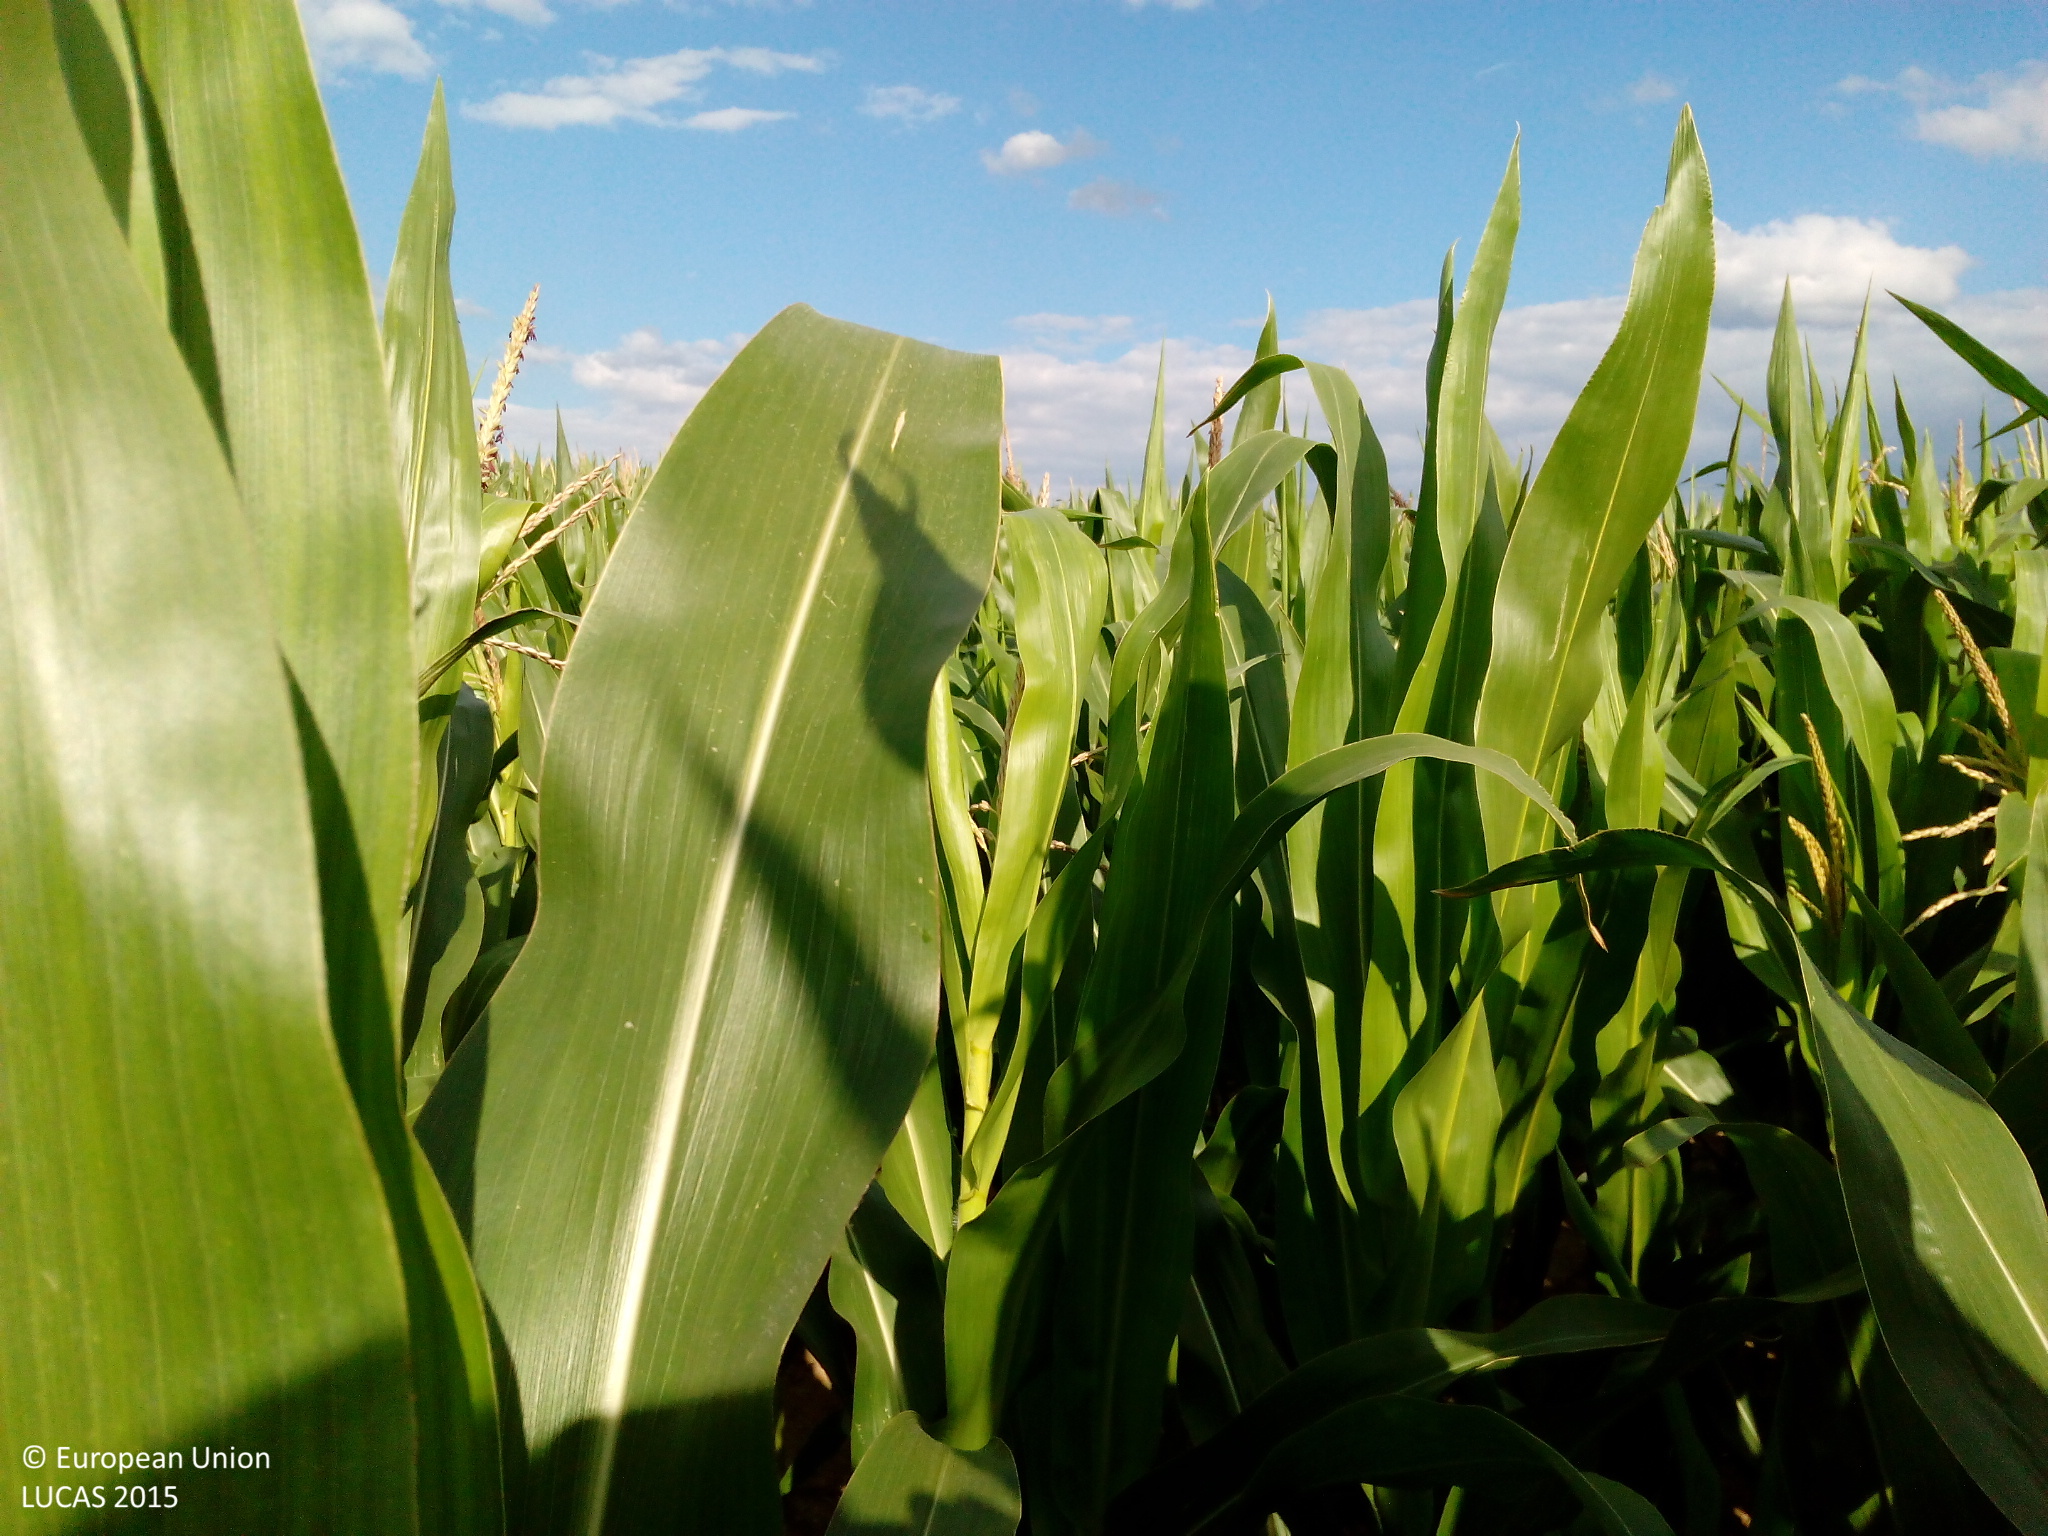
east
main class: Cropland
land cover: Maize
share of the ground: > 75 %
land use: Agriculture (excluding fallow land and kitchen gardens)
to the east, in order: Maize; Tracks; Grass margins; Common wheat
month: July
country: DE
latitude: 49.8716
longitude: 12.3789
